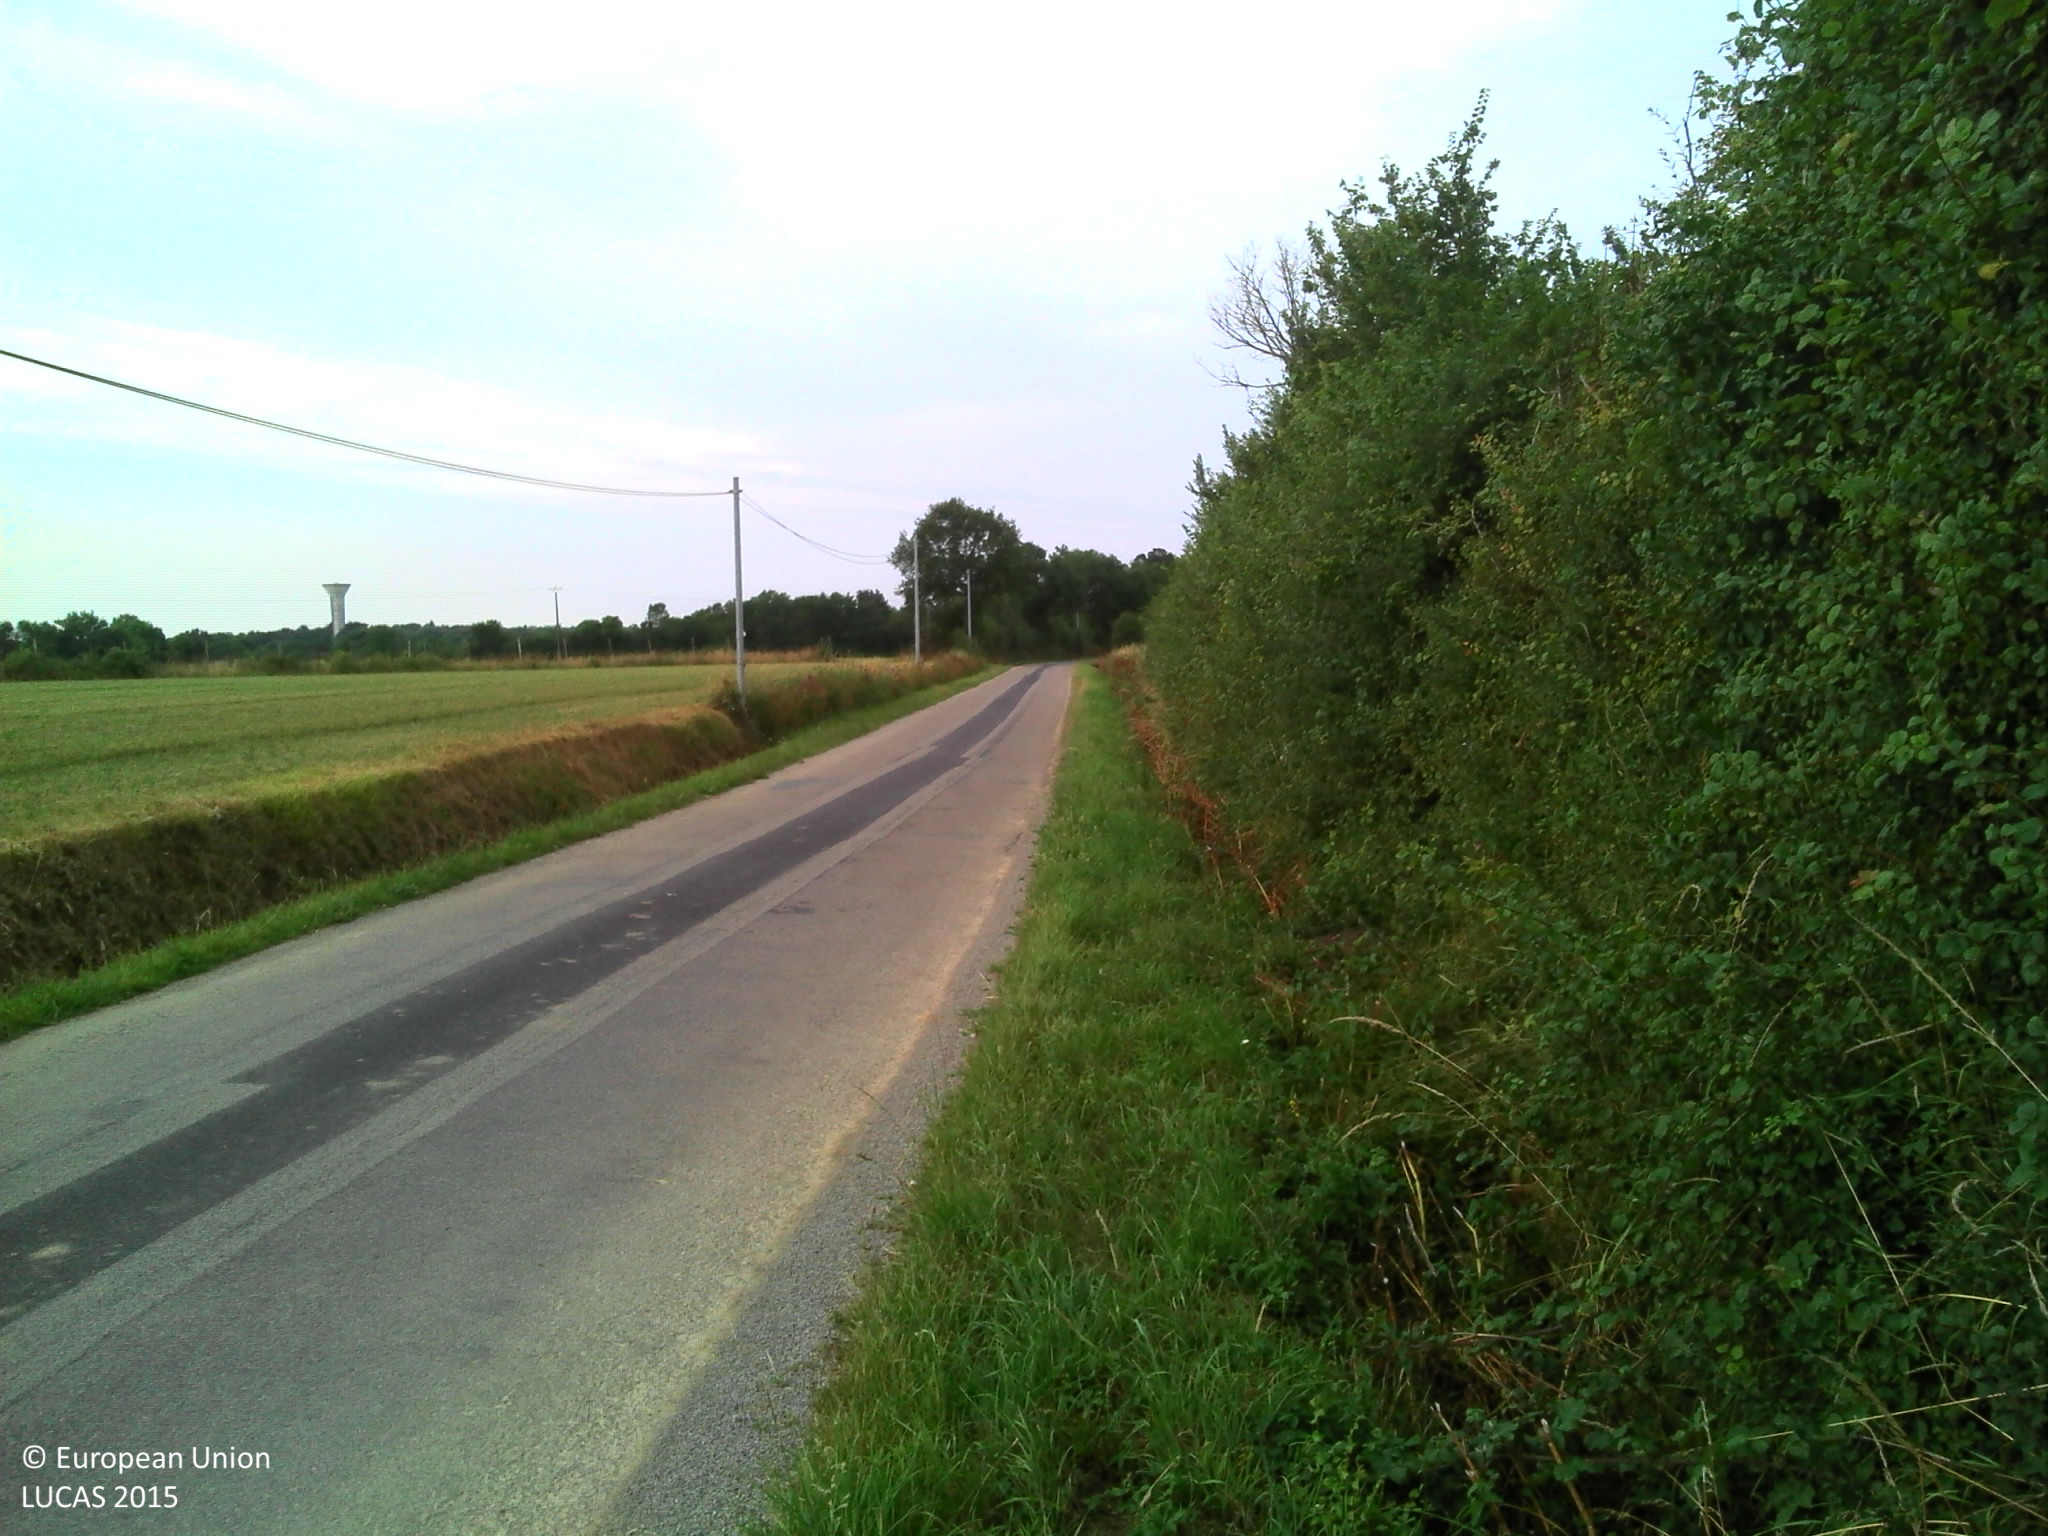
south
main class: Cropland
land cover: Temporary grasslands
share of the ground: > 75 %
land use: Agriculture (excluding fallow land and kitchen gardens)
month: July
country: FR
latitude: 47.1158
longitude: -1.7877
